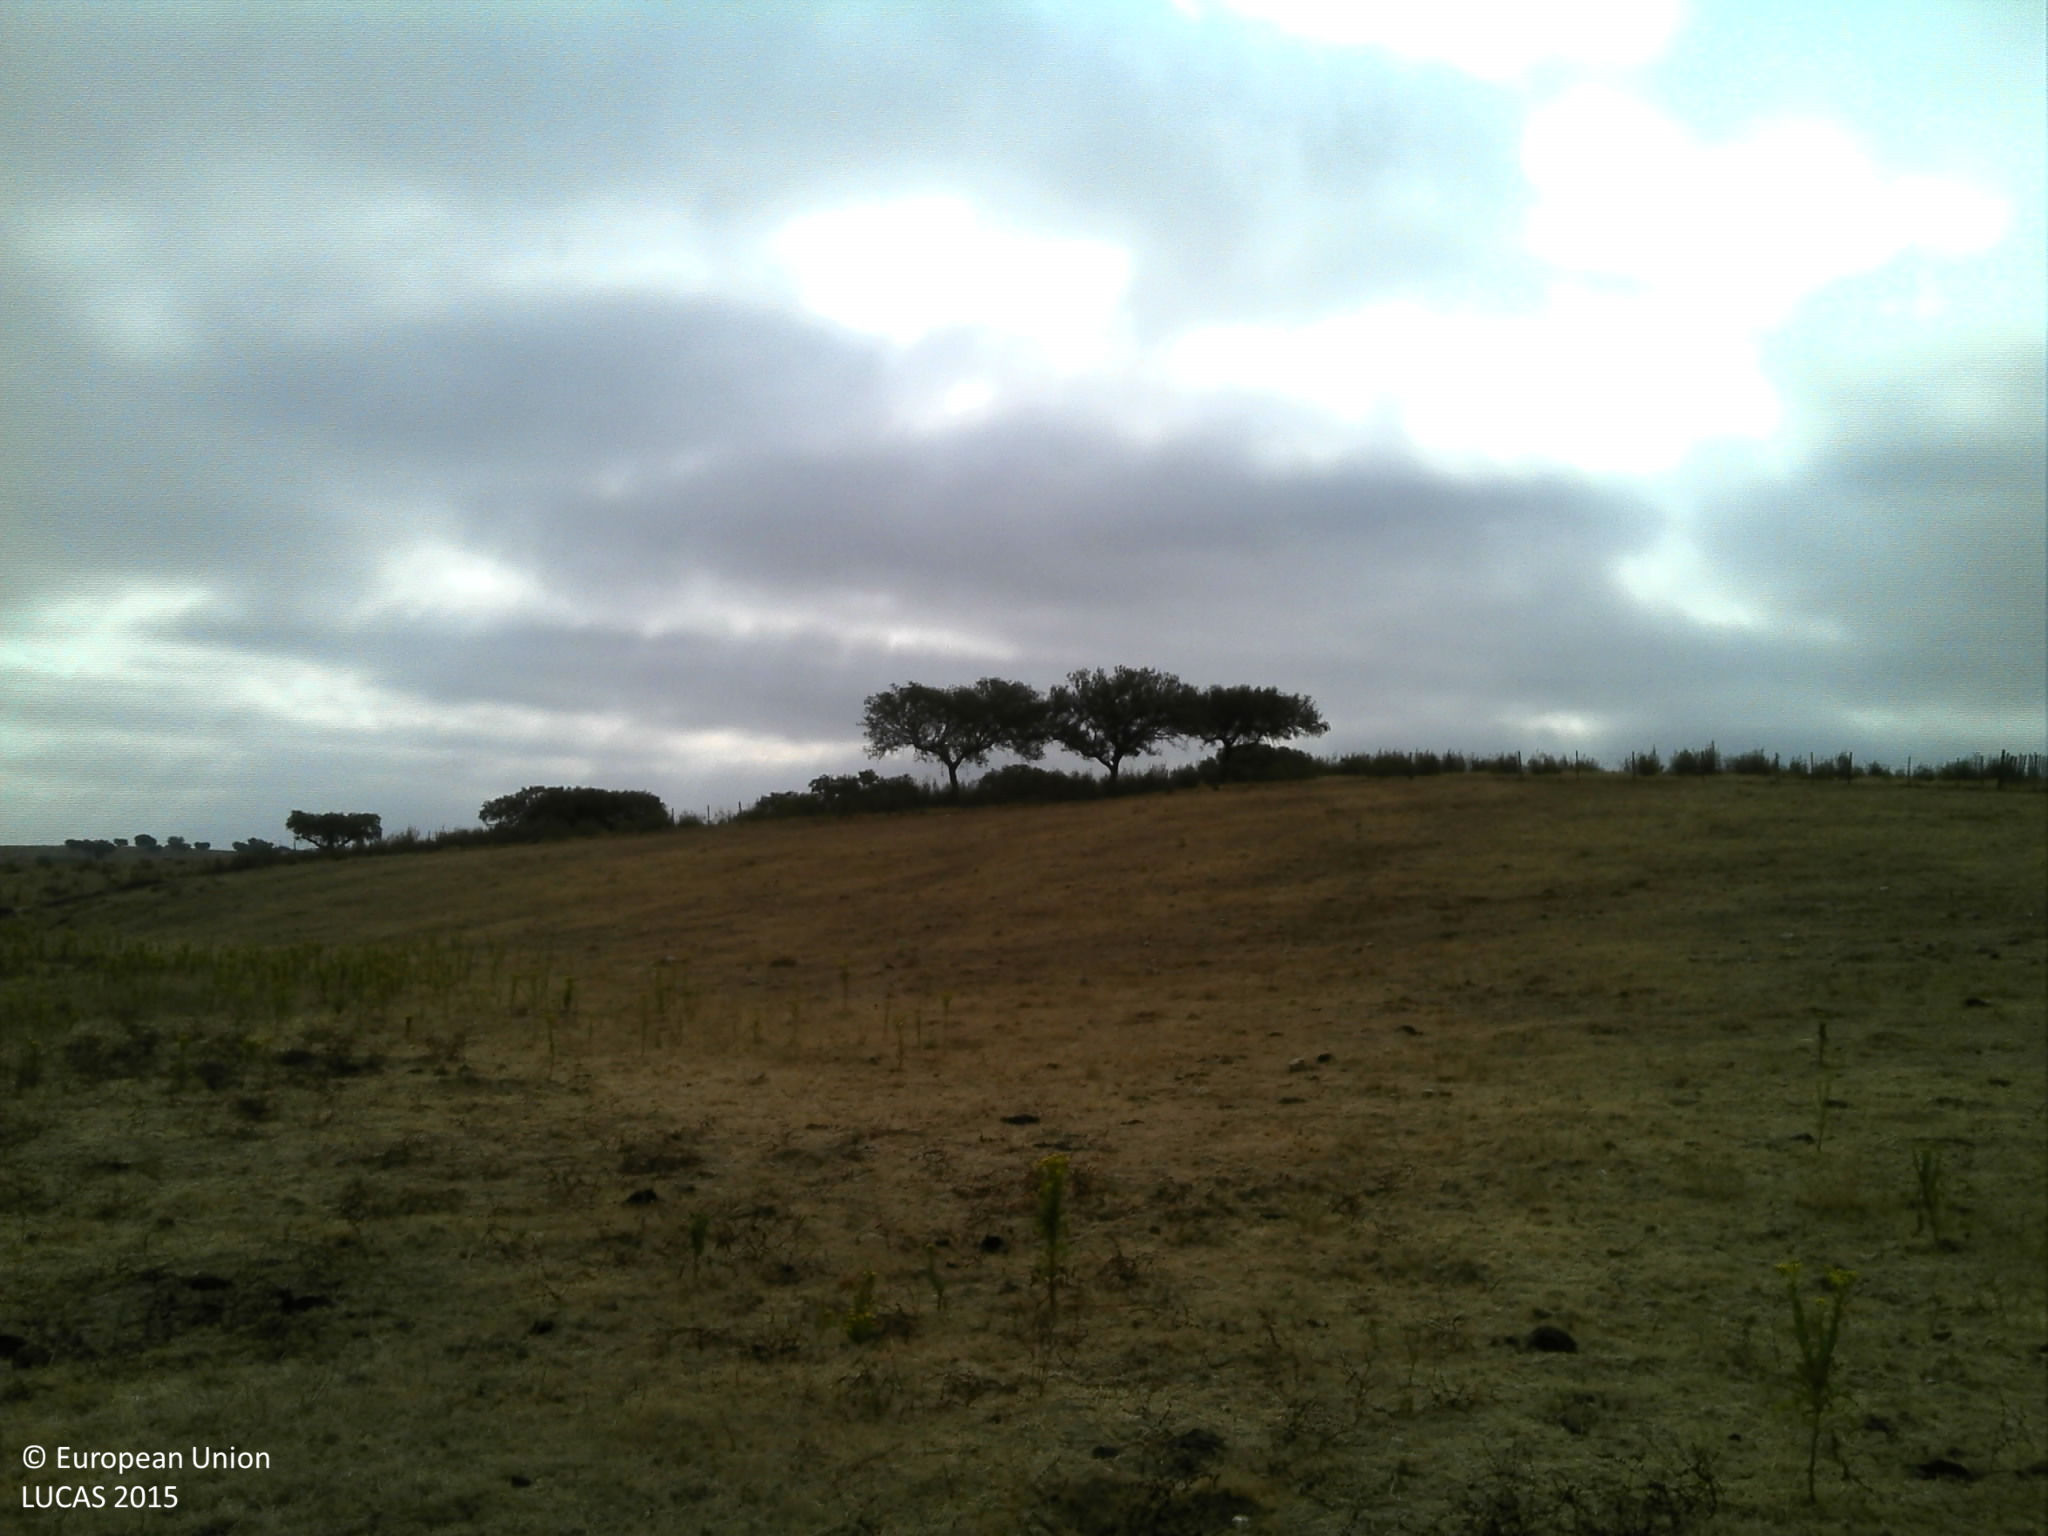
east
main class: Grassland
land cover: Grassland without tree/shrub cover
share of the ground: 25 - 50 %
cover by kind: unconsolidated bare surface 75 %, herbaceous plants 25 %
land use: Agriculture (excluding fallow land and kitchen gardens)
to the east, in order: Grassland without tree/shrub cover; Fences; Broadleaved woodland; Grassland with sparse tree/shrub cover; Tracks; Grassland without tree/shrub cover
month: July
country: PT
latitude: 38.4829
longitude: -7.3698
